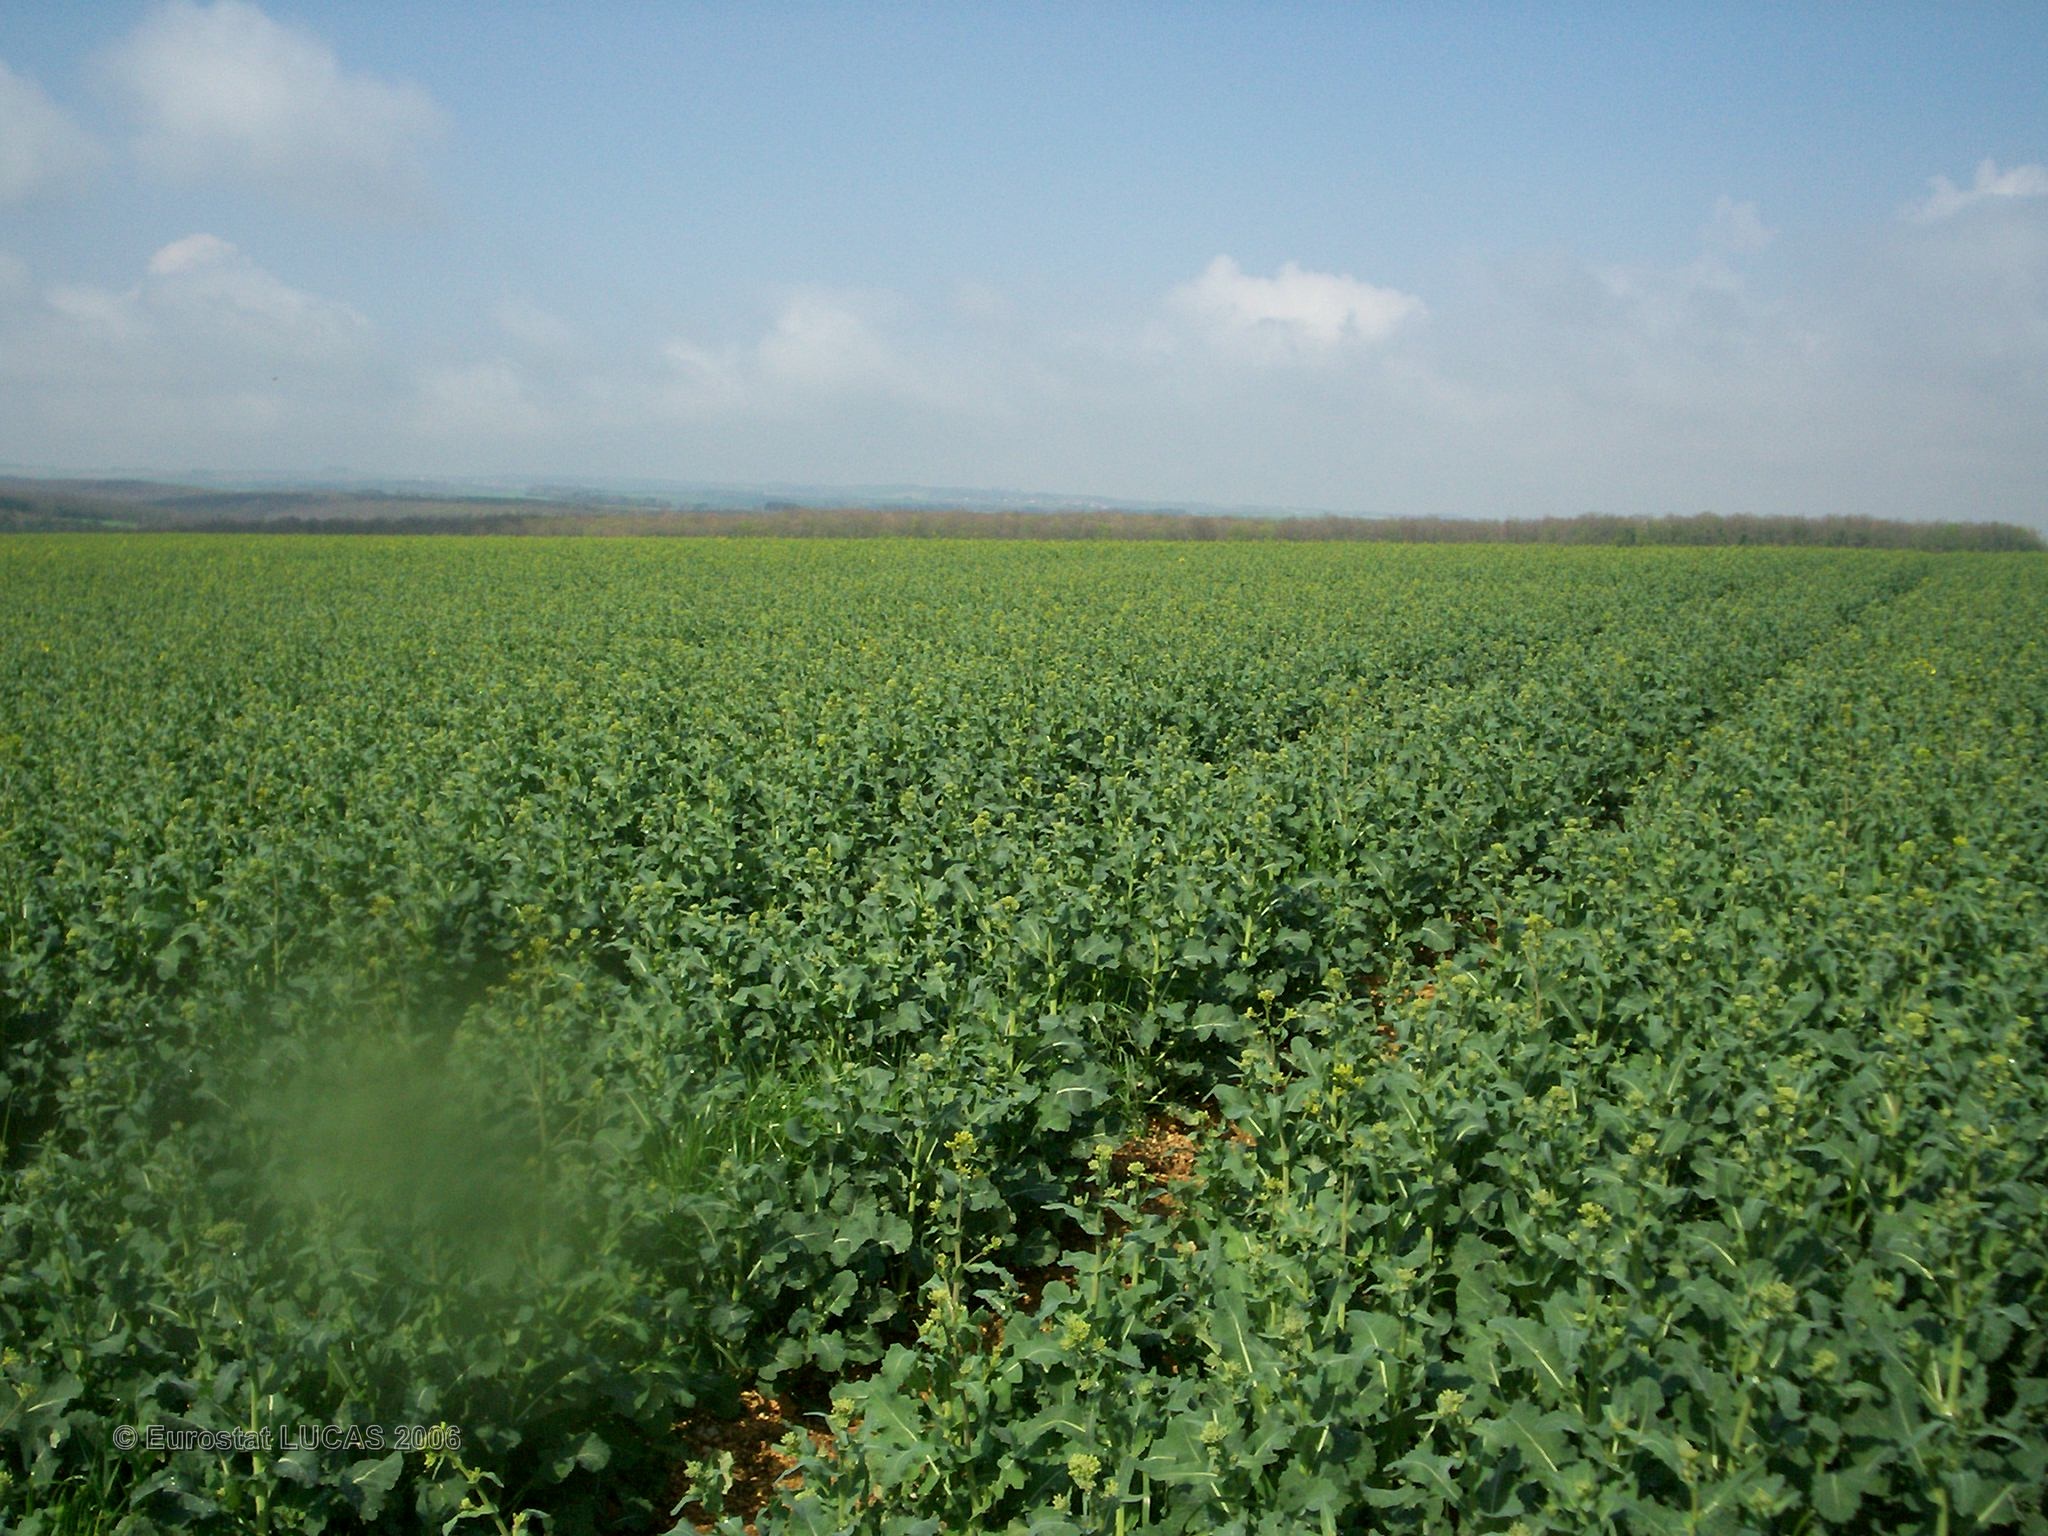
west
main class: Cropland
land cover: Rape and turnip rape
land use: Agriculture (excluding fallow land and kitchen gardens)
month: April
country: FR
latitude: 47.7449
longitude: 3.8483
